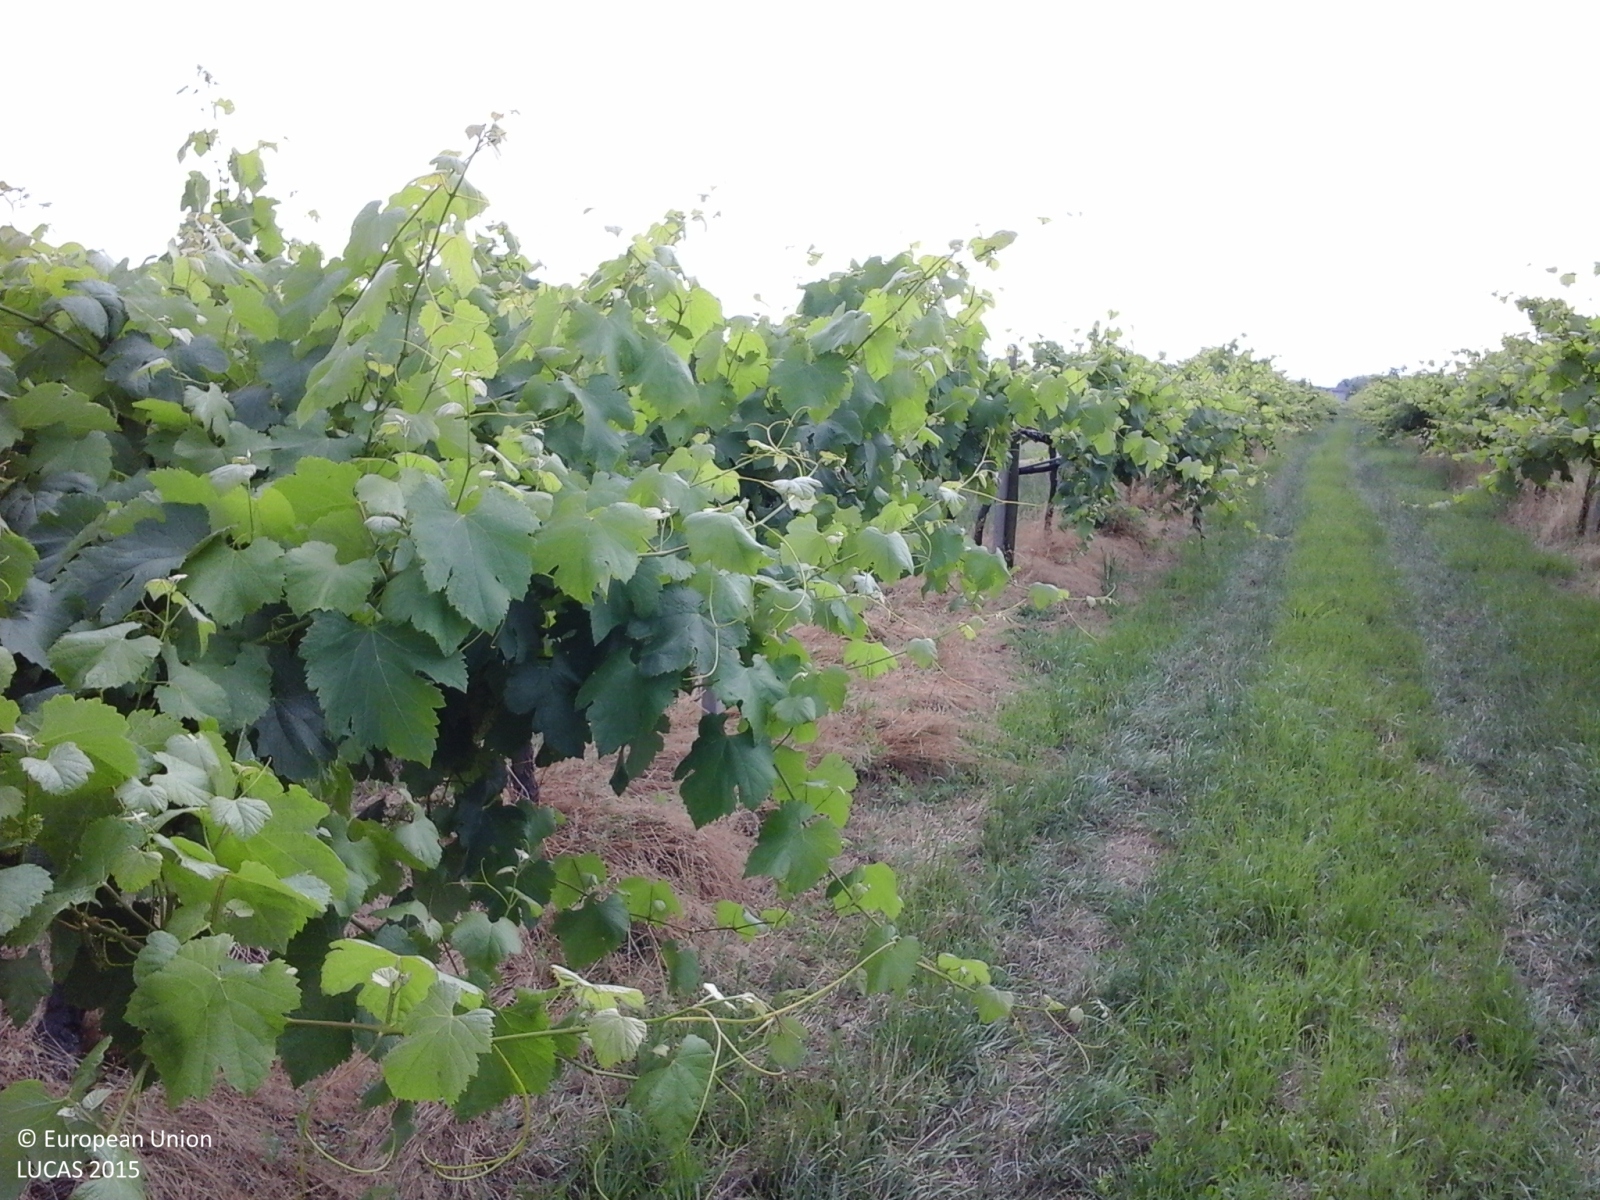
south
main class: Cropland
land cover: Vineyards
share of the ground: 25 - 50 %
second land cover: Grassland without tree/shrub cover
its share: 50 - 75 %
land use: Agriculture (excluding fallow land and kitchen gardens)
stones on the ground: < 10 %
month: May
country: IT
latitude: 44.7630
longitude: 10.6934
